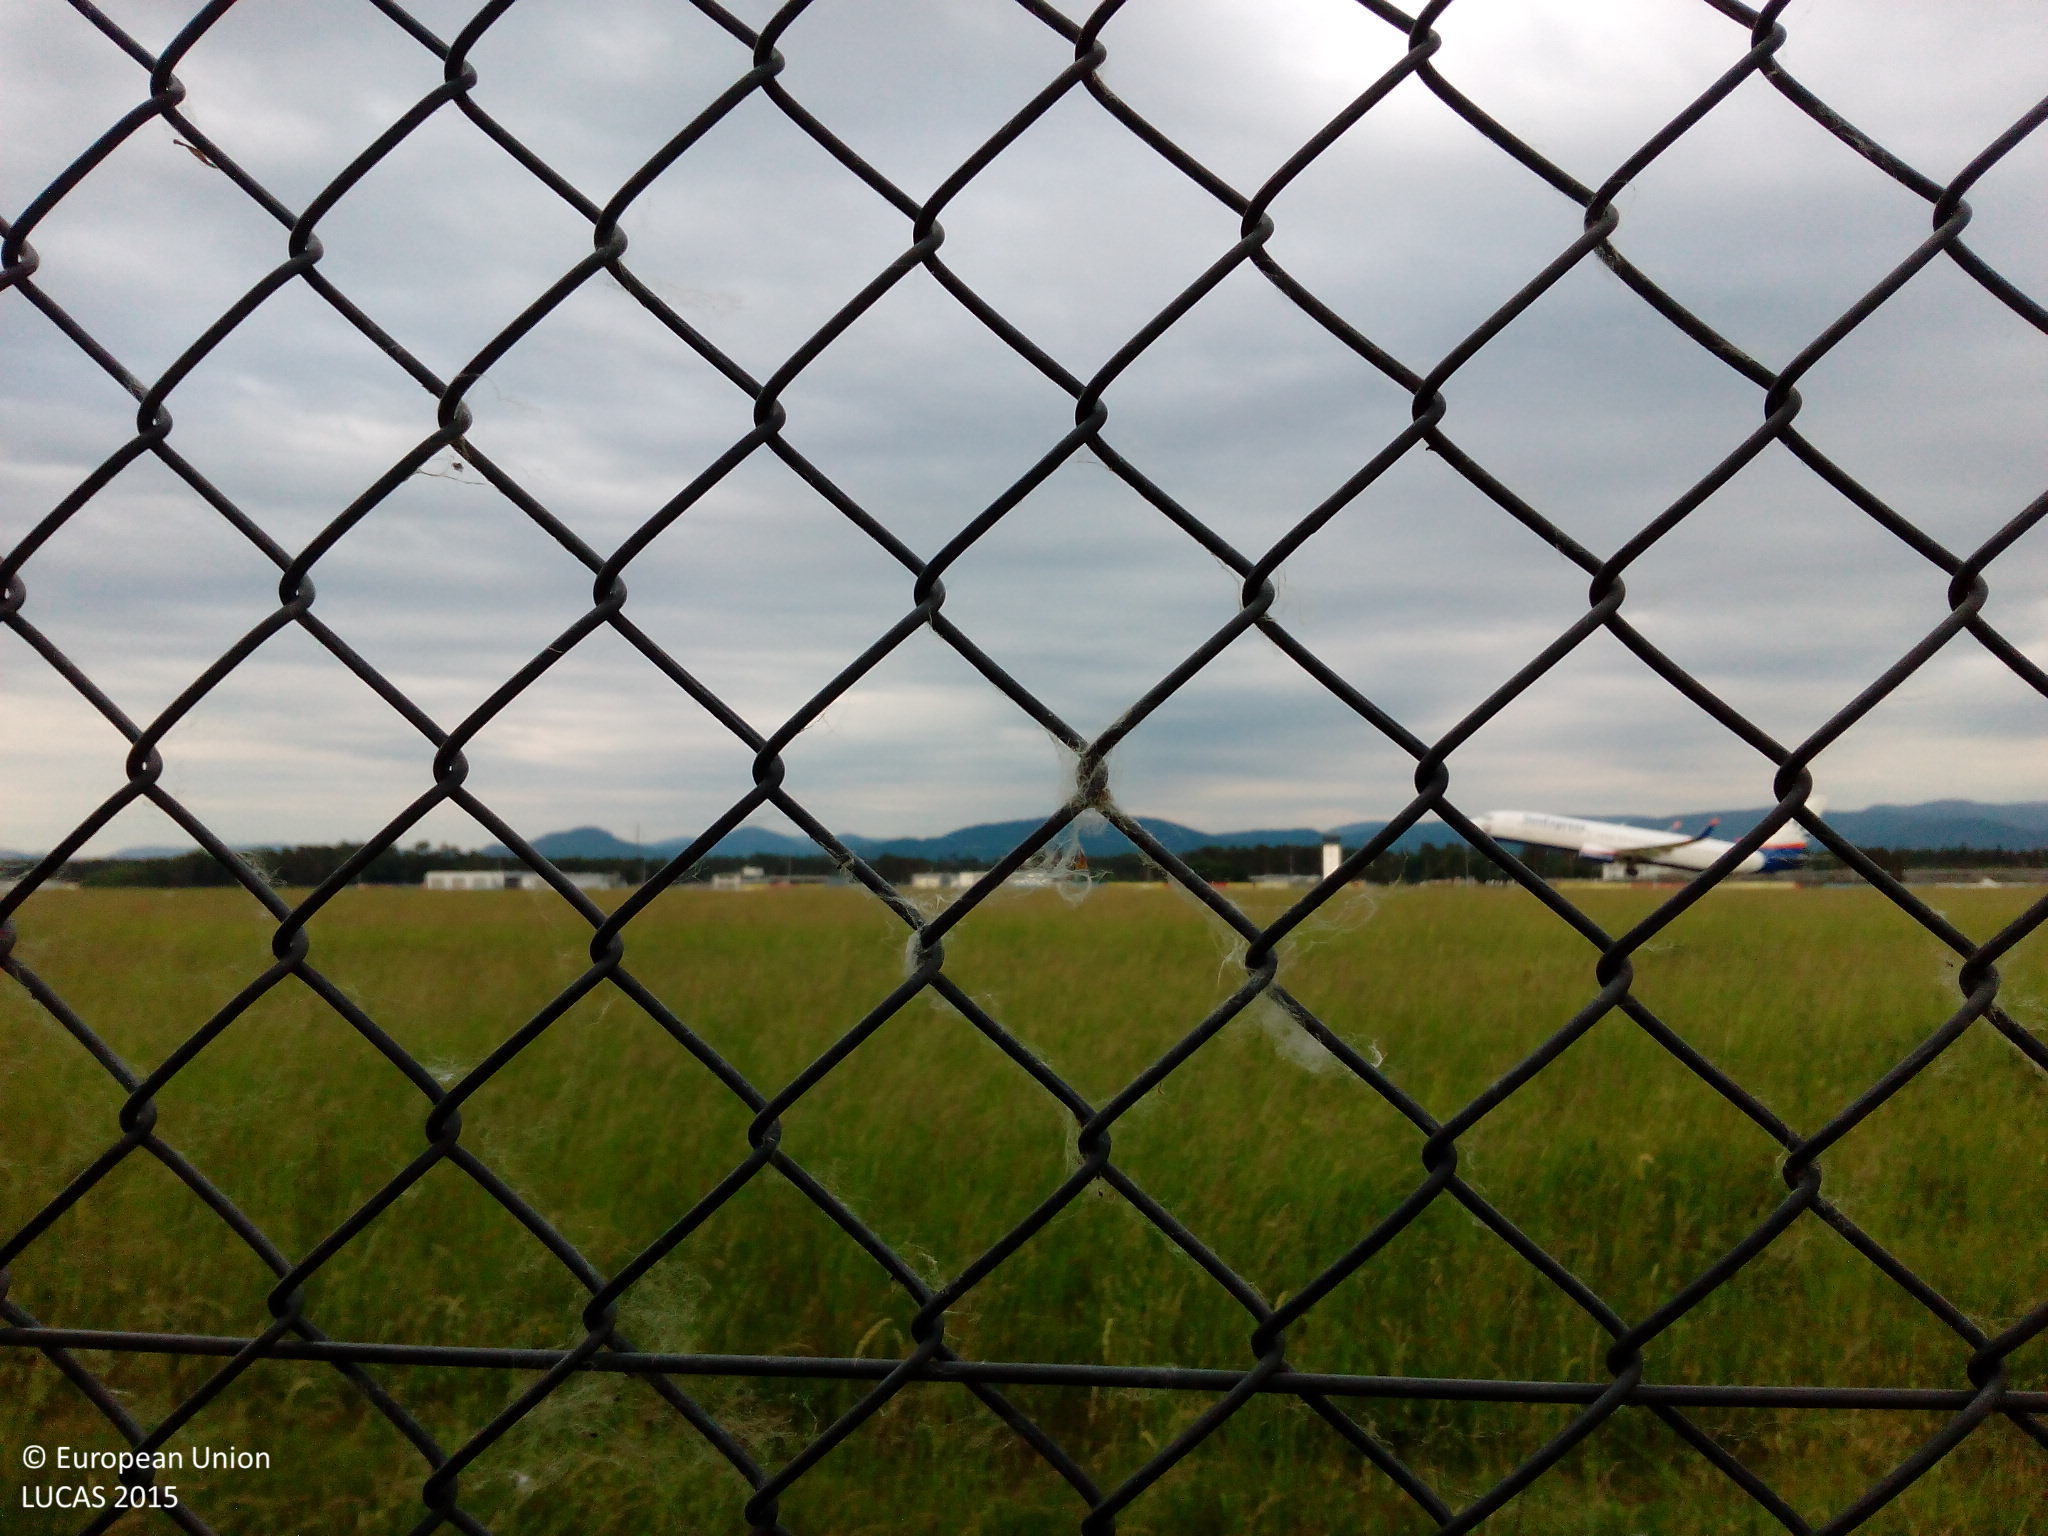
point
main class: Grassland
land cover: Grassland without tree/shrub cover
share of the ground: > 75 %
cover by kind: herbaceous plants 95 %, consolidated bare surface 5 %
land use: Air transport
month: May
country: DE
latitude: 48.7828
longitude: 8.0817
